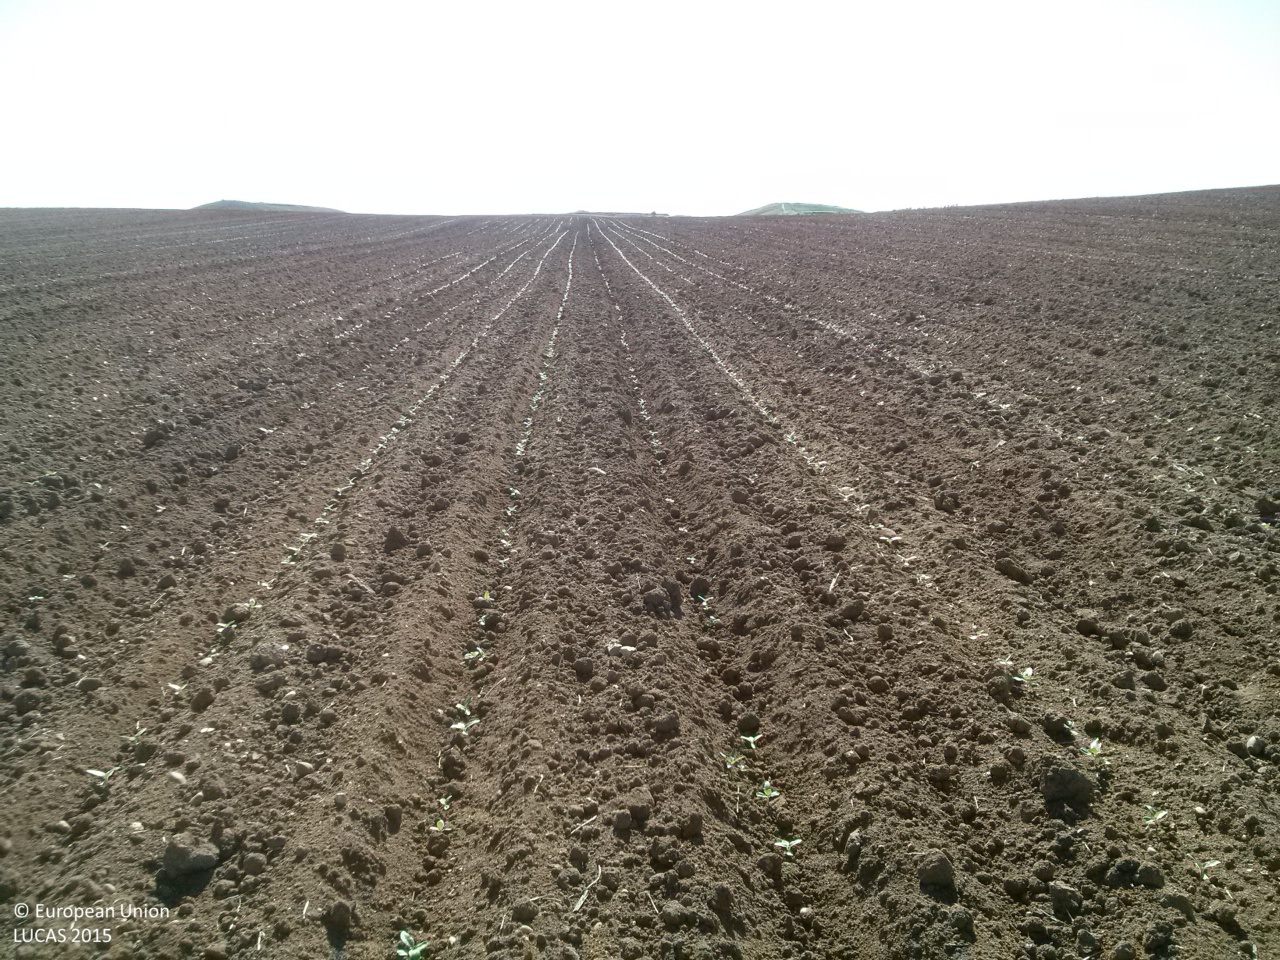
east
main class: Cropland
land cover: Sunflower
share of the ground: < 10 %
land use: Agriculture (excluding fallow land and kitchen gardens)
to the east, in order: Sunflower
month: May
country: ES
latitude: 40.0280
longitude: -2.8062
